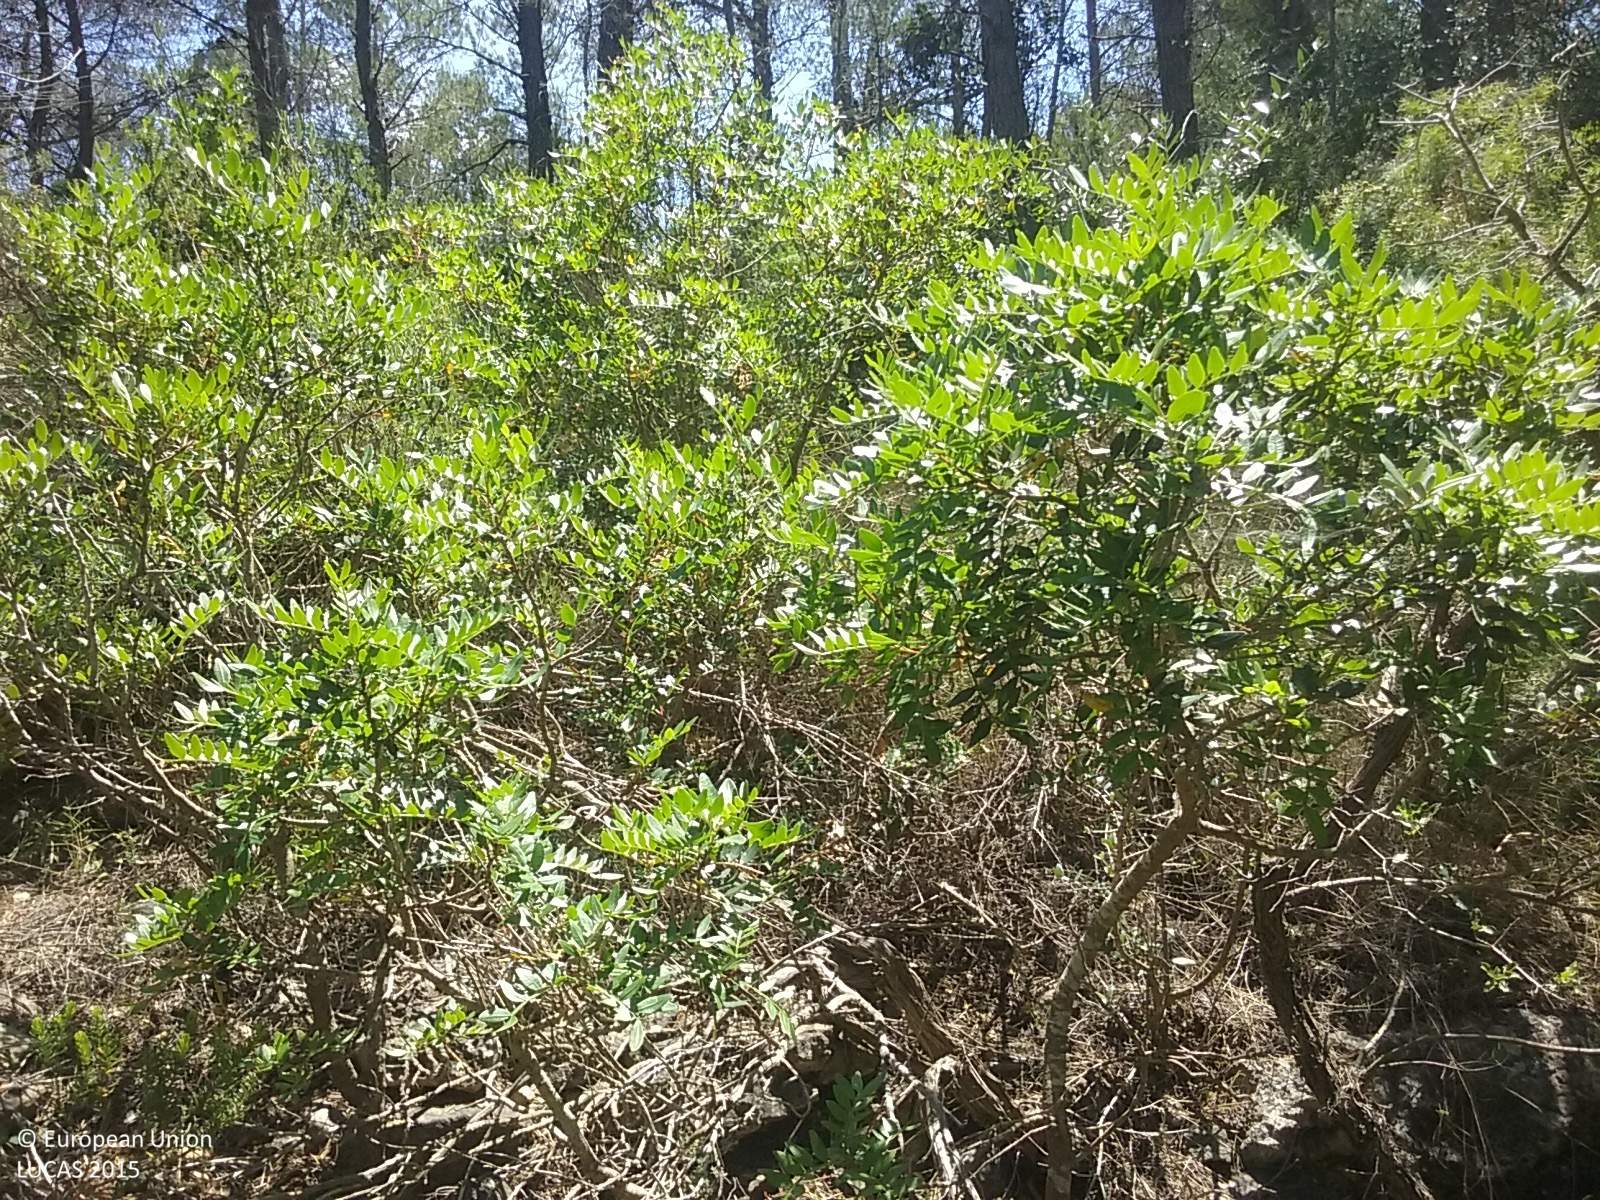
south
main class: Woodland
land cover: Pine dominated coniferous woodland
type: coniferous forest of the mediterranean region
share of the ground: > 75 %
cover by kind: coniferous forest trees 75 %, shrubs 20 %, herbaceous plants 5 %
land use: Semi-natural and natural areas not in use
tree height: > 5 m
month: June
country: ES
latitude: 40.9969
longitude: 0.5892
